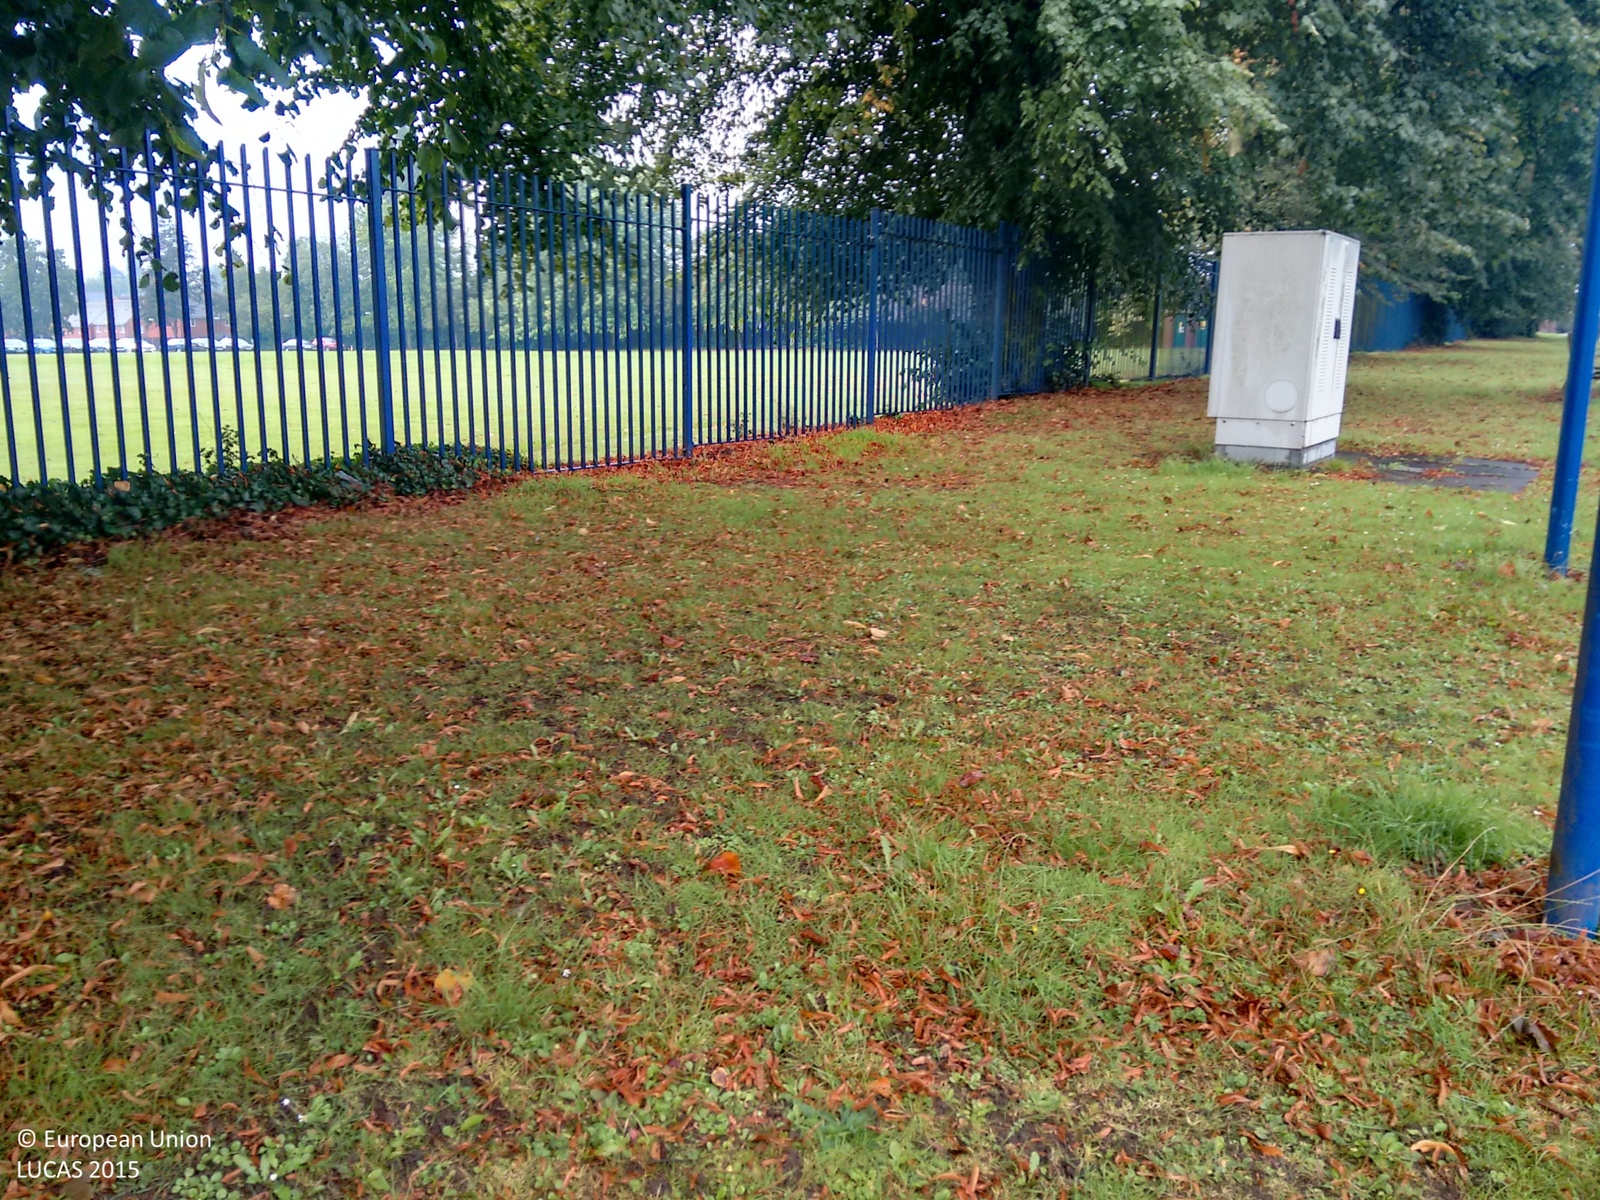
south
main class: Grassland
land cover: Grassland with sparse tree/shrub cover
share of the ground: > 75 %
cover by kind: herbaceous plants 65 %, consolidated bare surface 30 %, broadleaved forest trees 5 %
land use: Amenities, museums, leisure
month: September
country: GB
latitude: 52.4047
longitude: -1.9789
